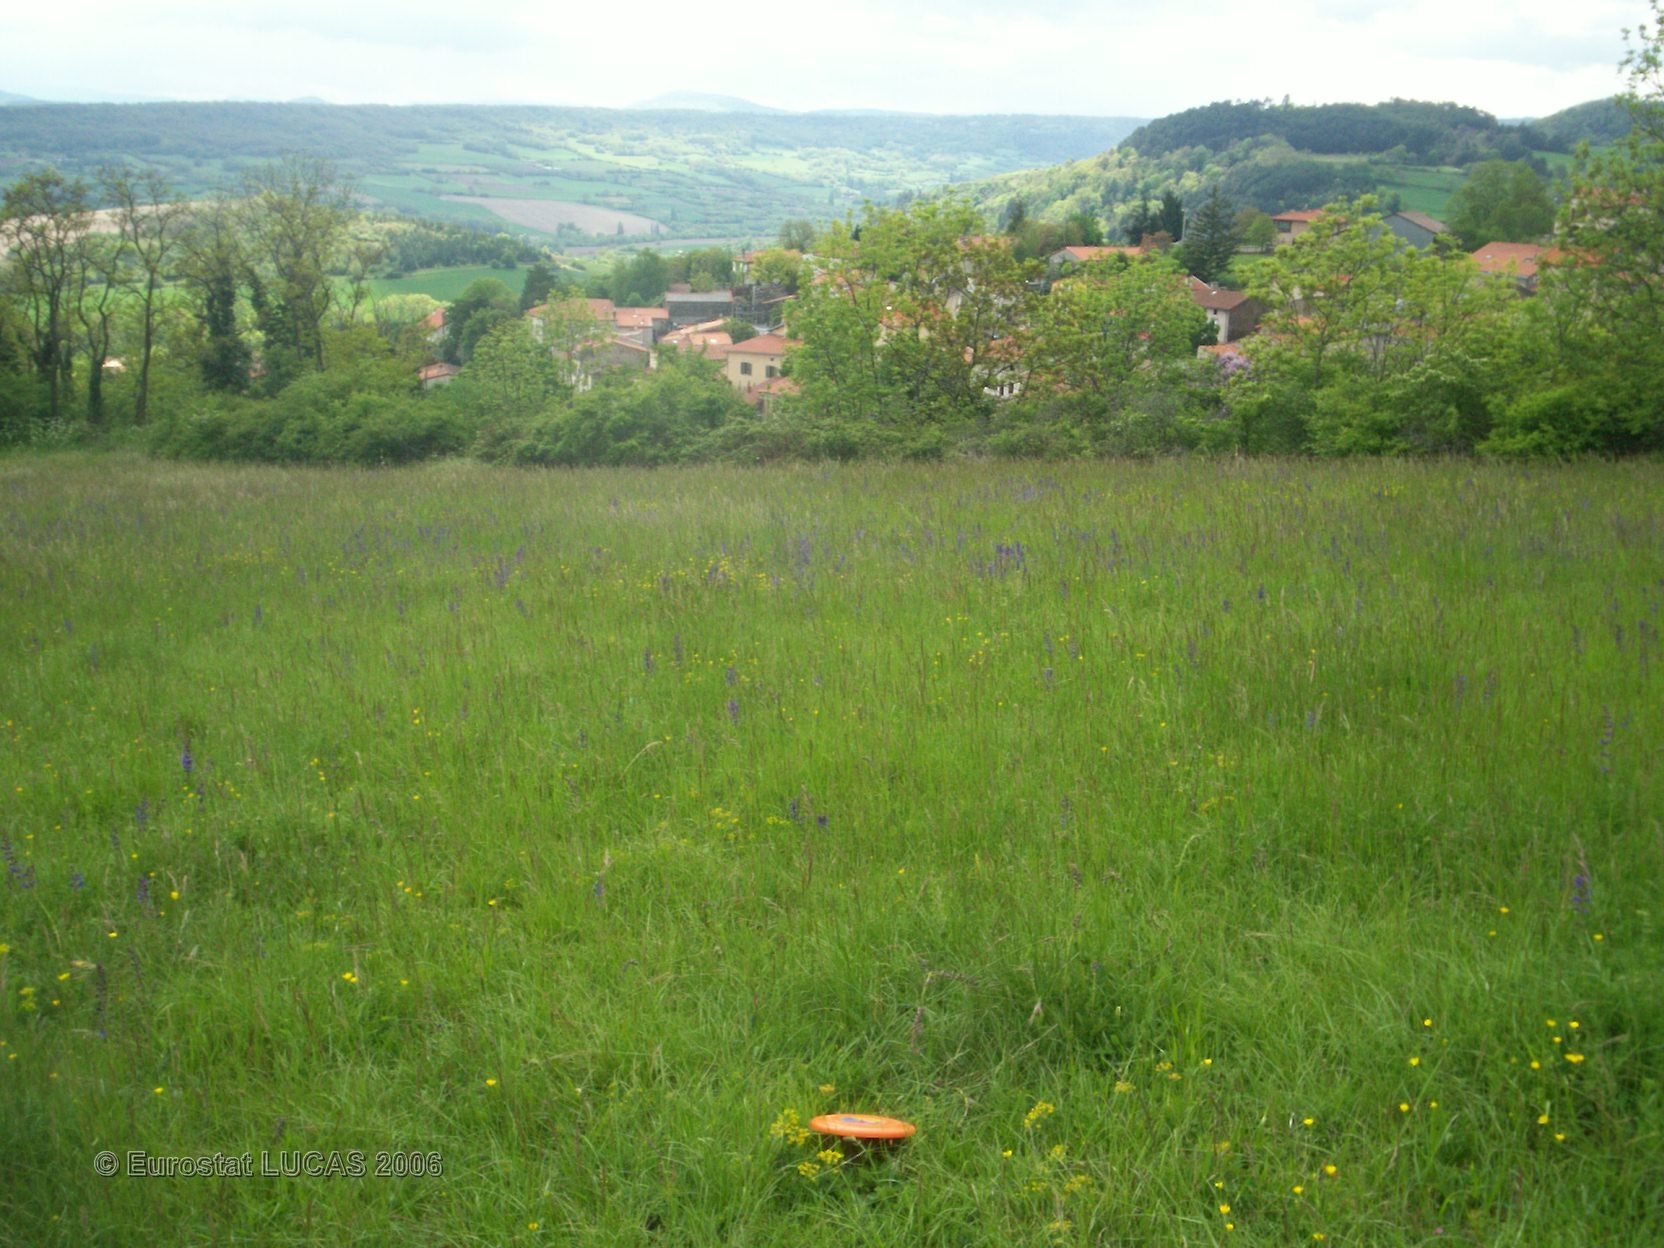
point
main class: Grassland
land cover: Grassland without tree/shrub cover
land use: Agriculture (excluding fallow land and kitchen gardens)
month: May
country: FR
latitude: 45.7143
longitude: 3.1272
